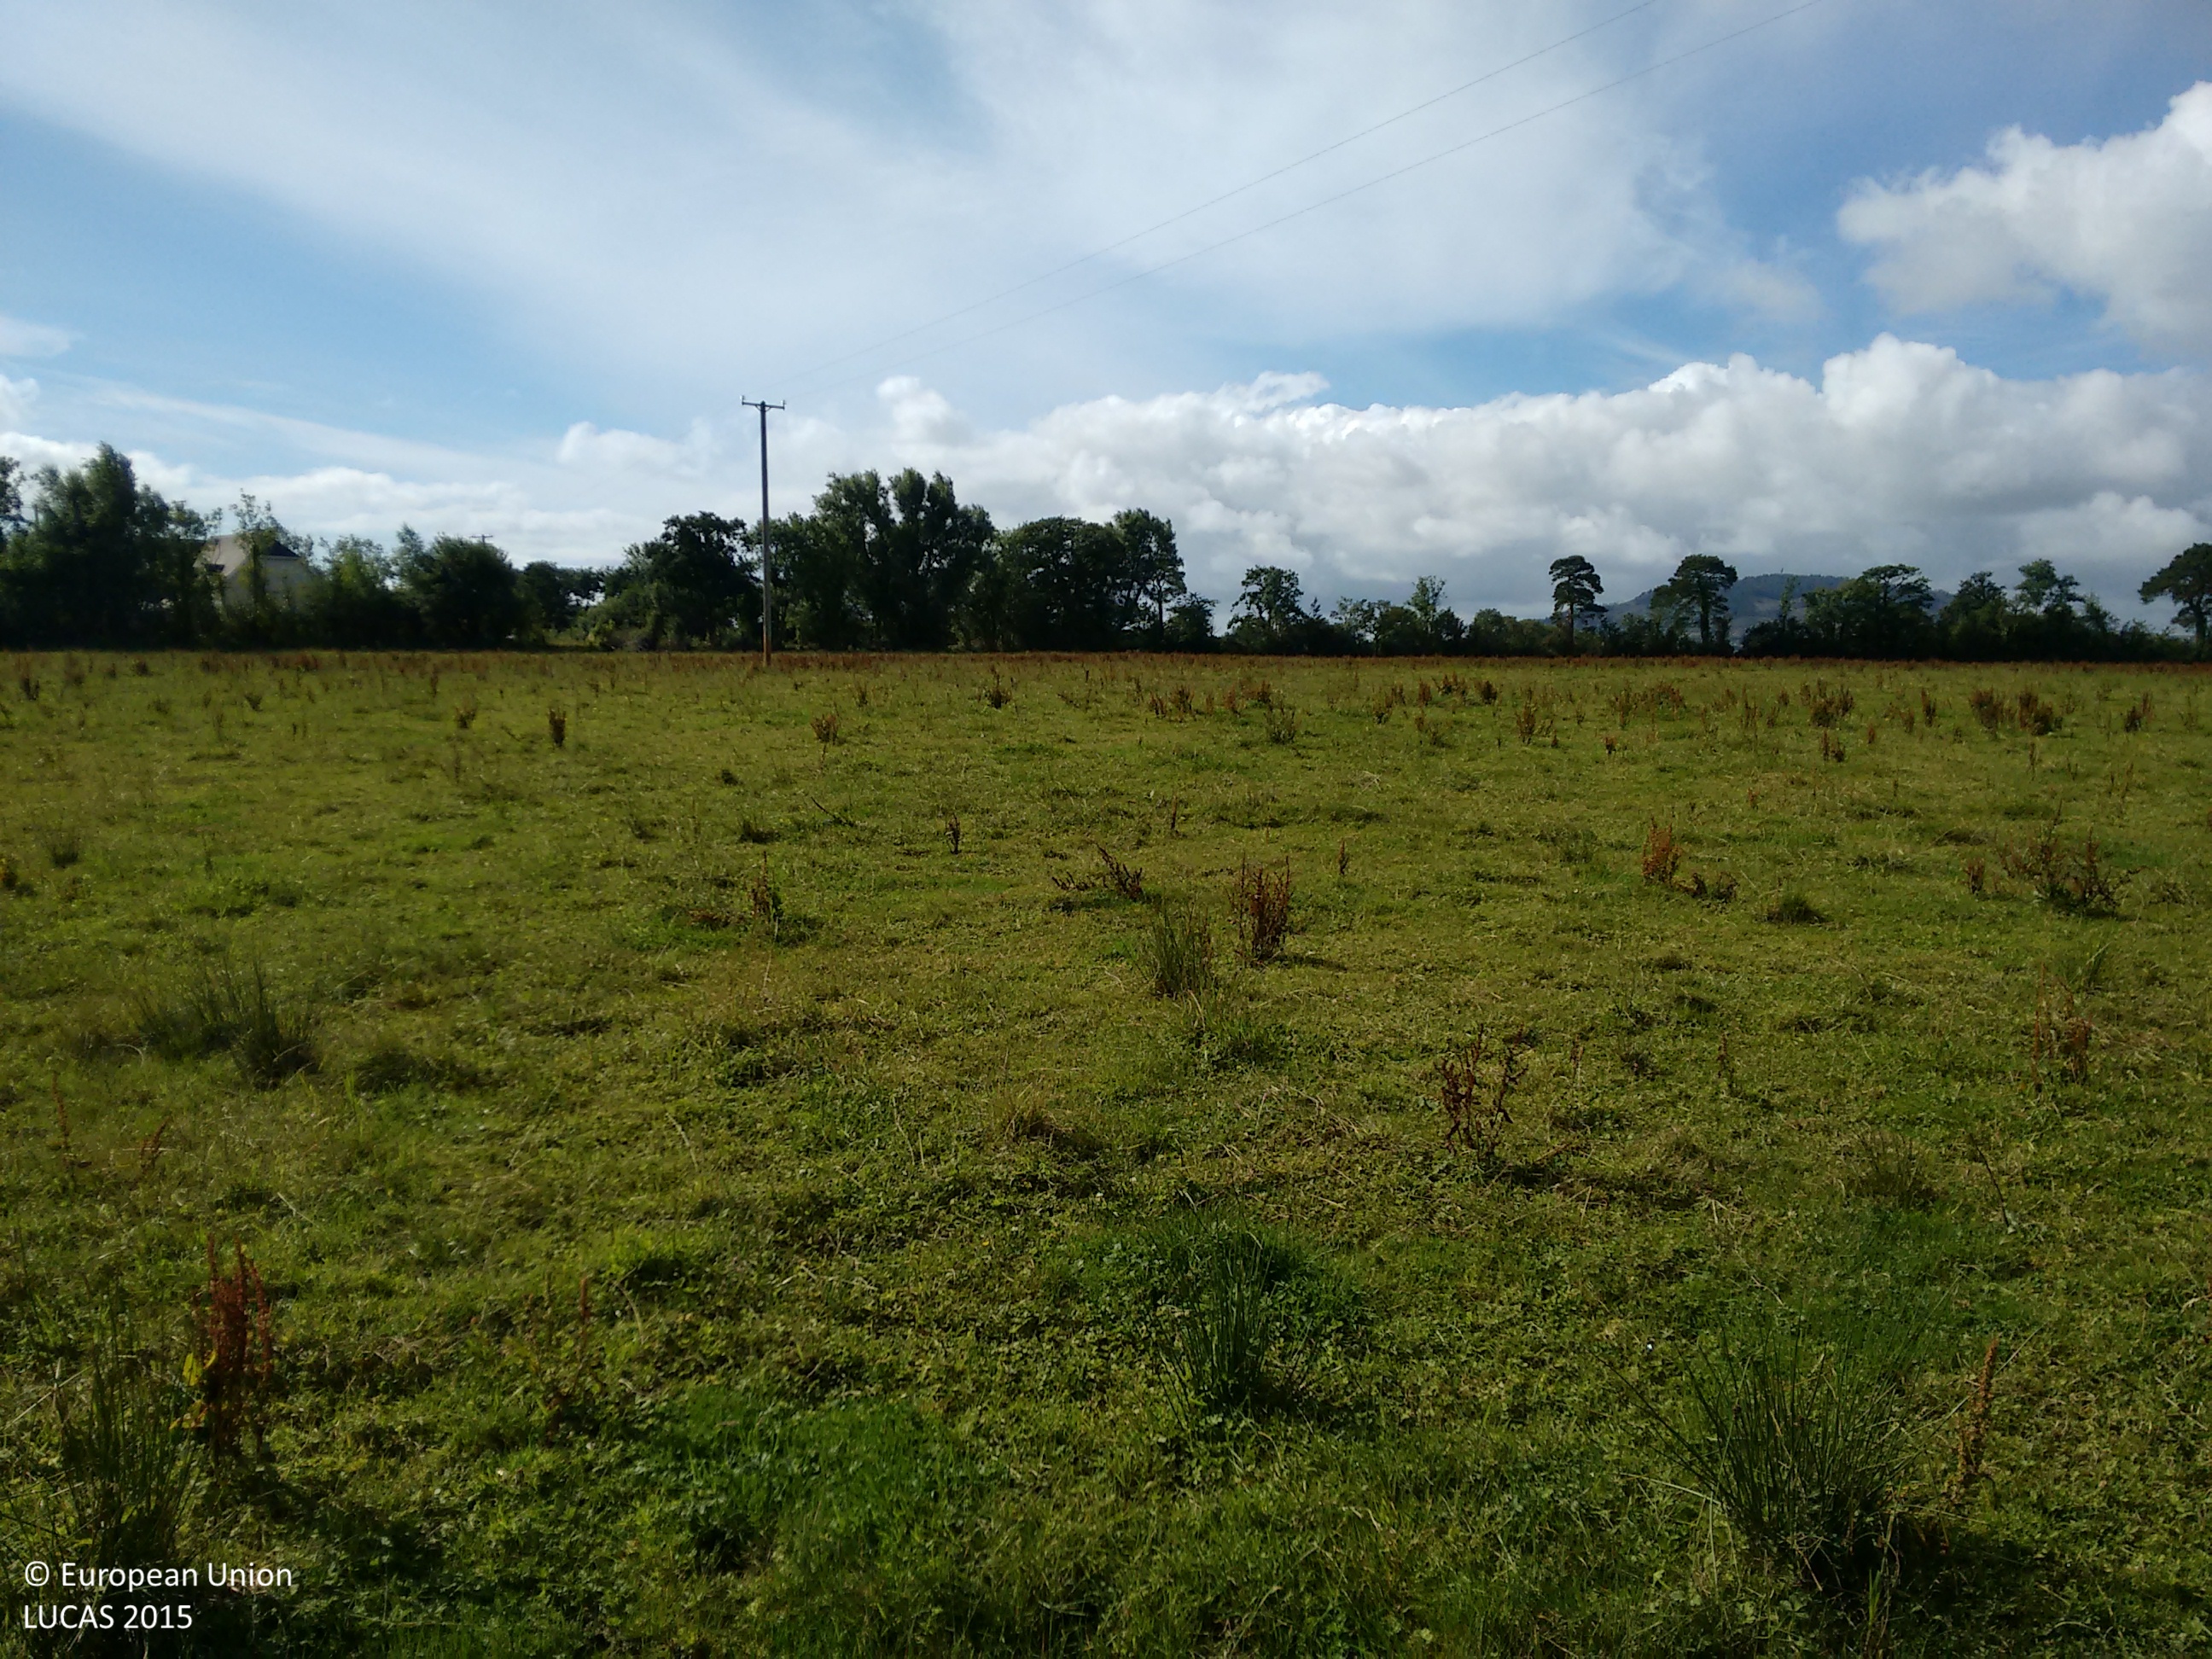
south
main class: Grassland
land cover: Grassland without tree/shrub cover
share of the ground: > 75 %
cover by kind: herbaceous plants 95 %, unconsolidated bare surface 5 %
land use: Agriculture (excluding fallow land and kitchen gardens)
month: August
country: IE
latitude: 52.7425
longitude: -6.1902
